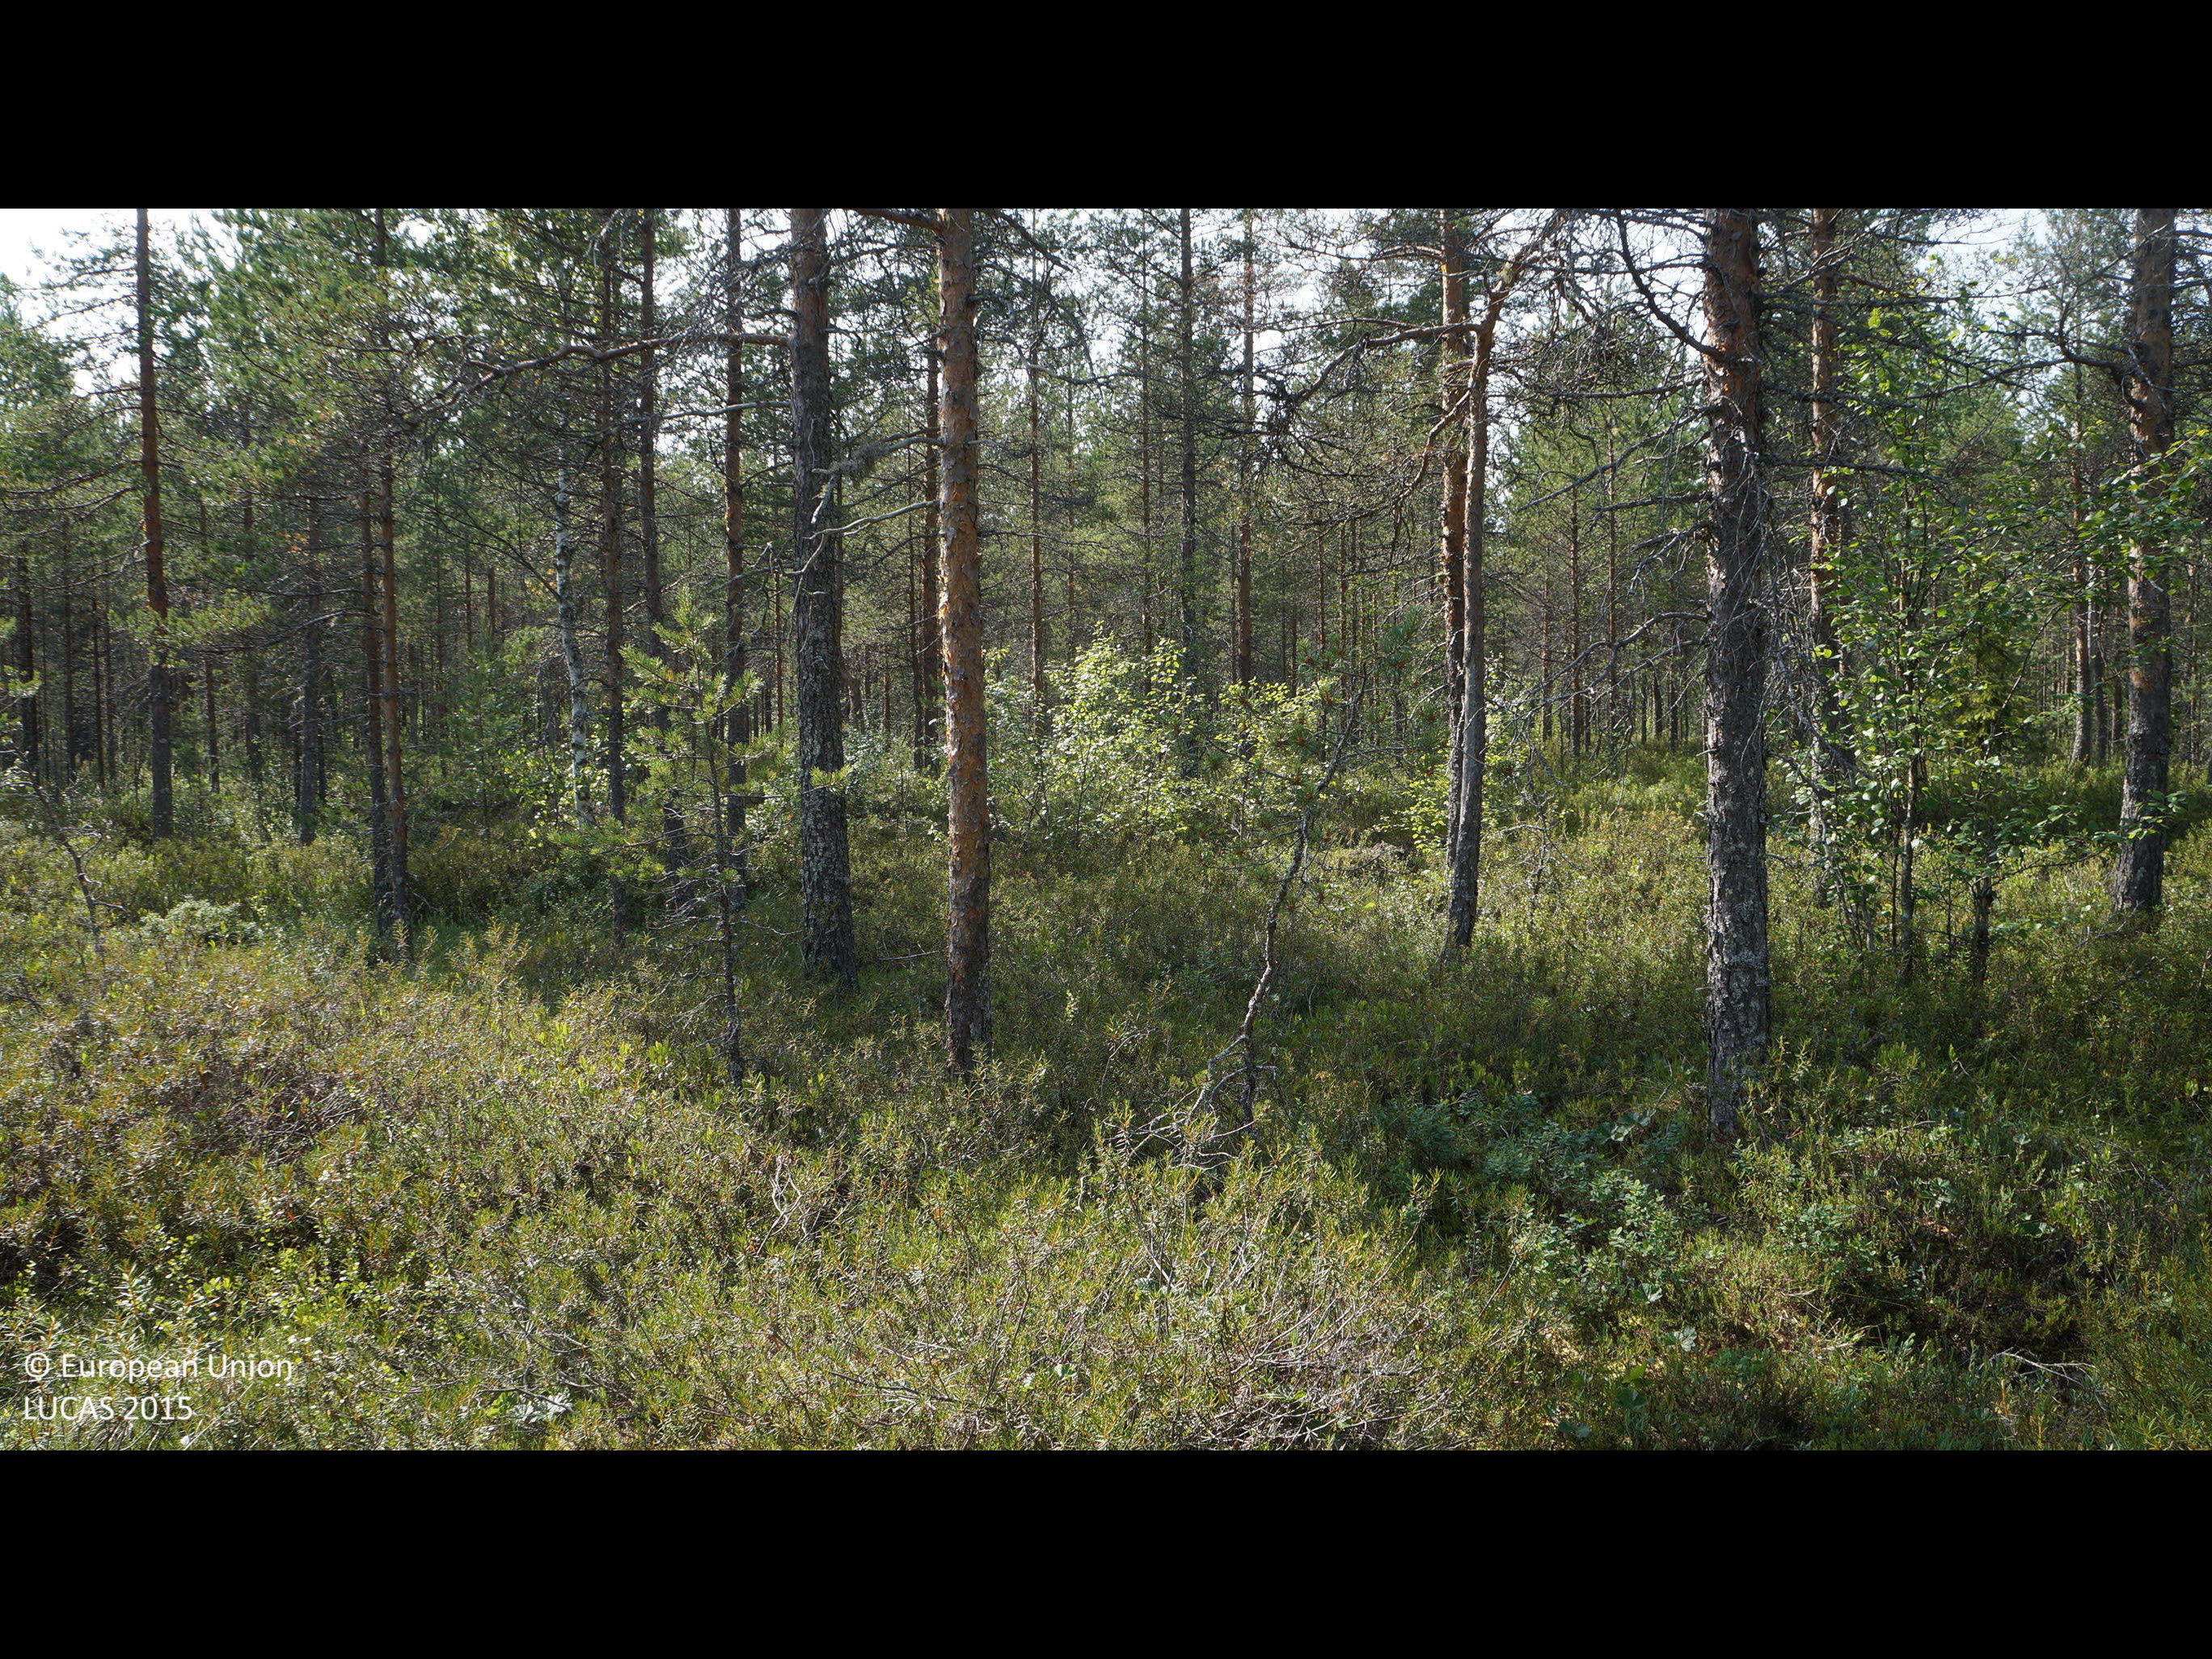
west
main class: Woodland
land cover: Pine dominated coniferous woodland
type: boreal forest
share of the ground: 25 - 50 %
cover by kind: coniferous forest trees 40 %, shrubs 40 %, lichens and mosses 20 %
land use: Forestry
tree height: > 5 m
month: July
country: FI
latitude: 64.4490
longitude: 24.4695
